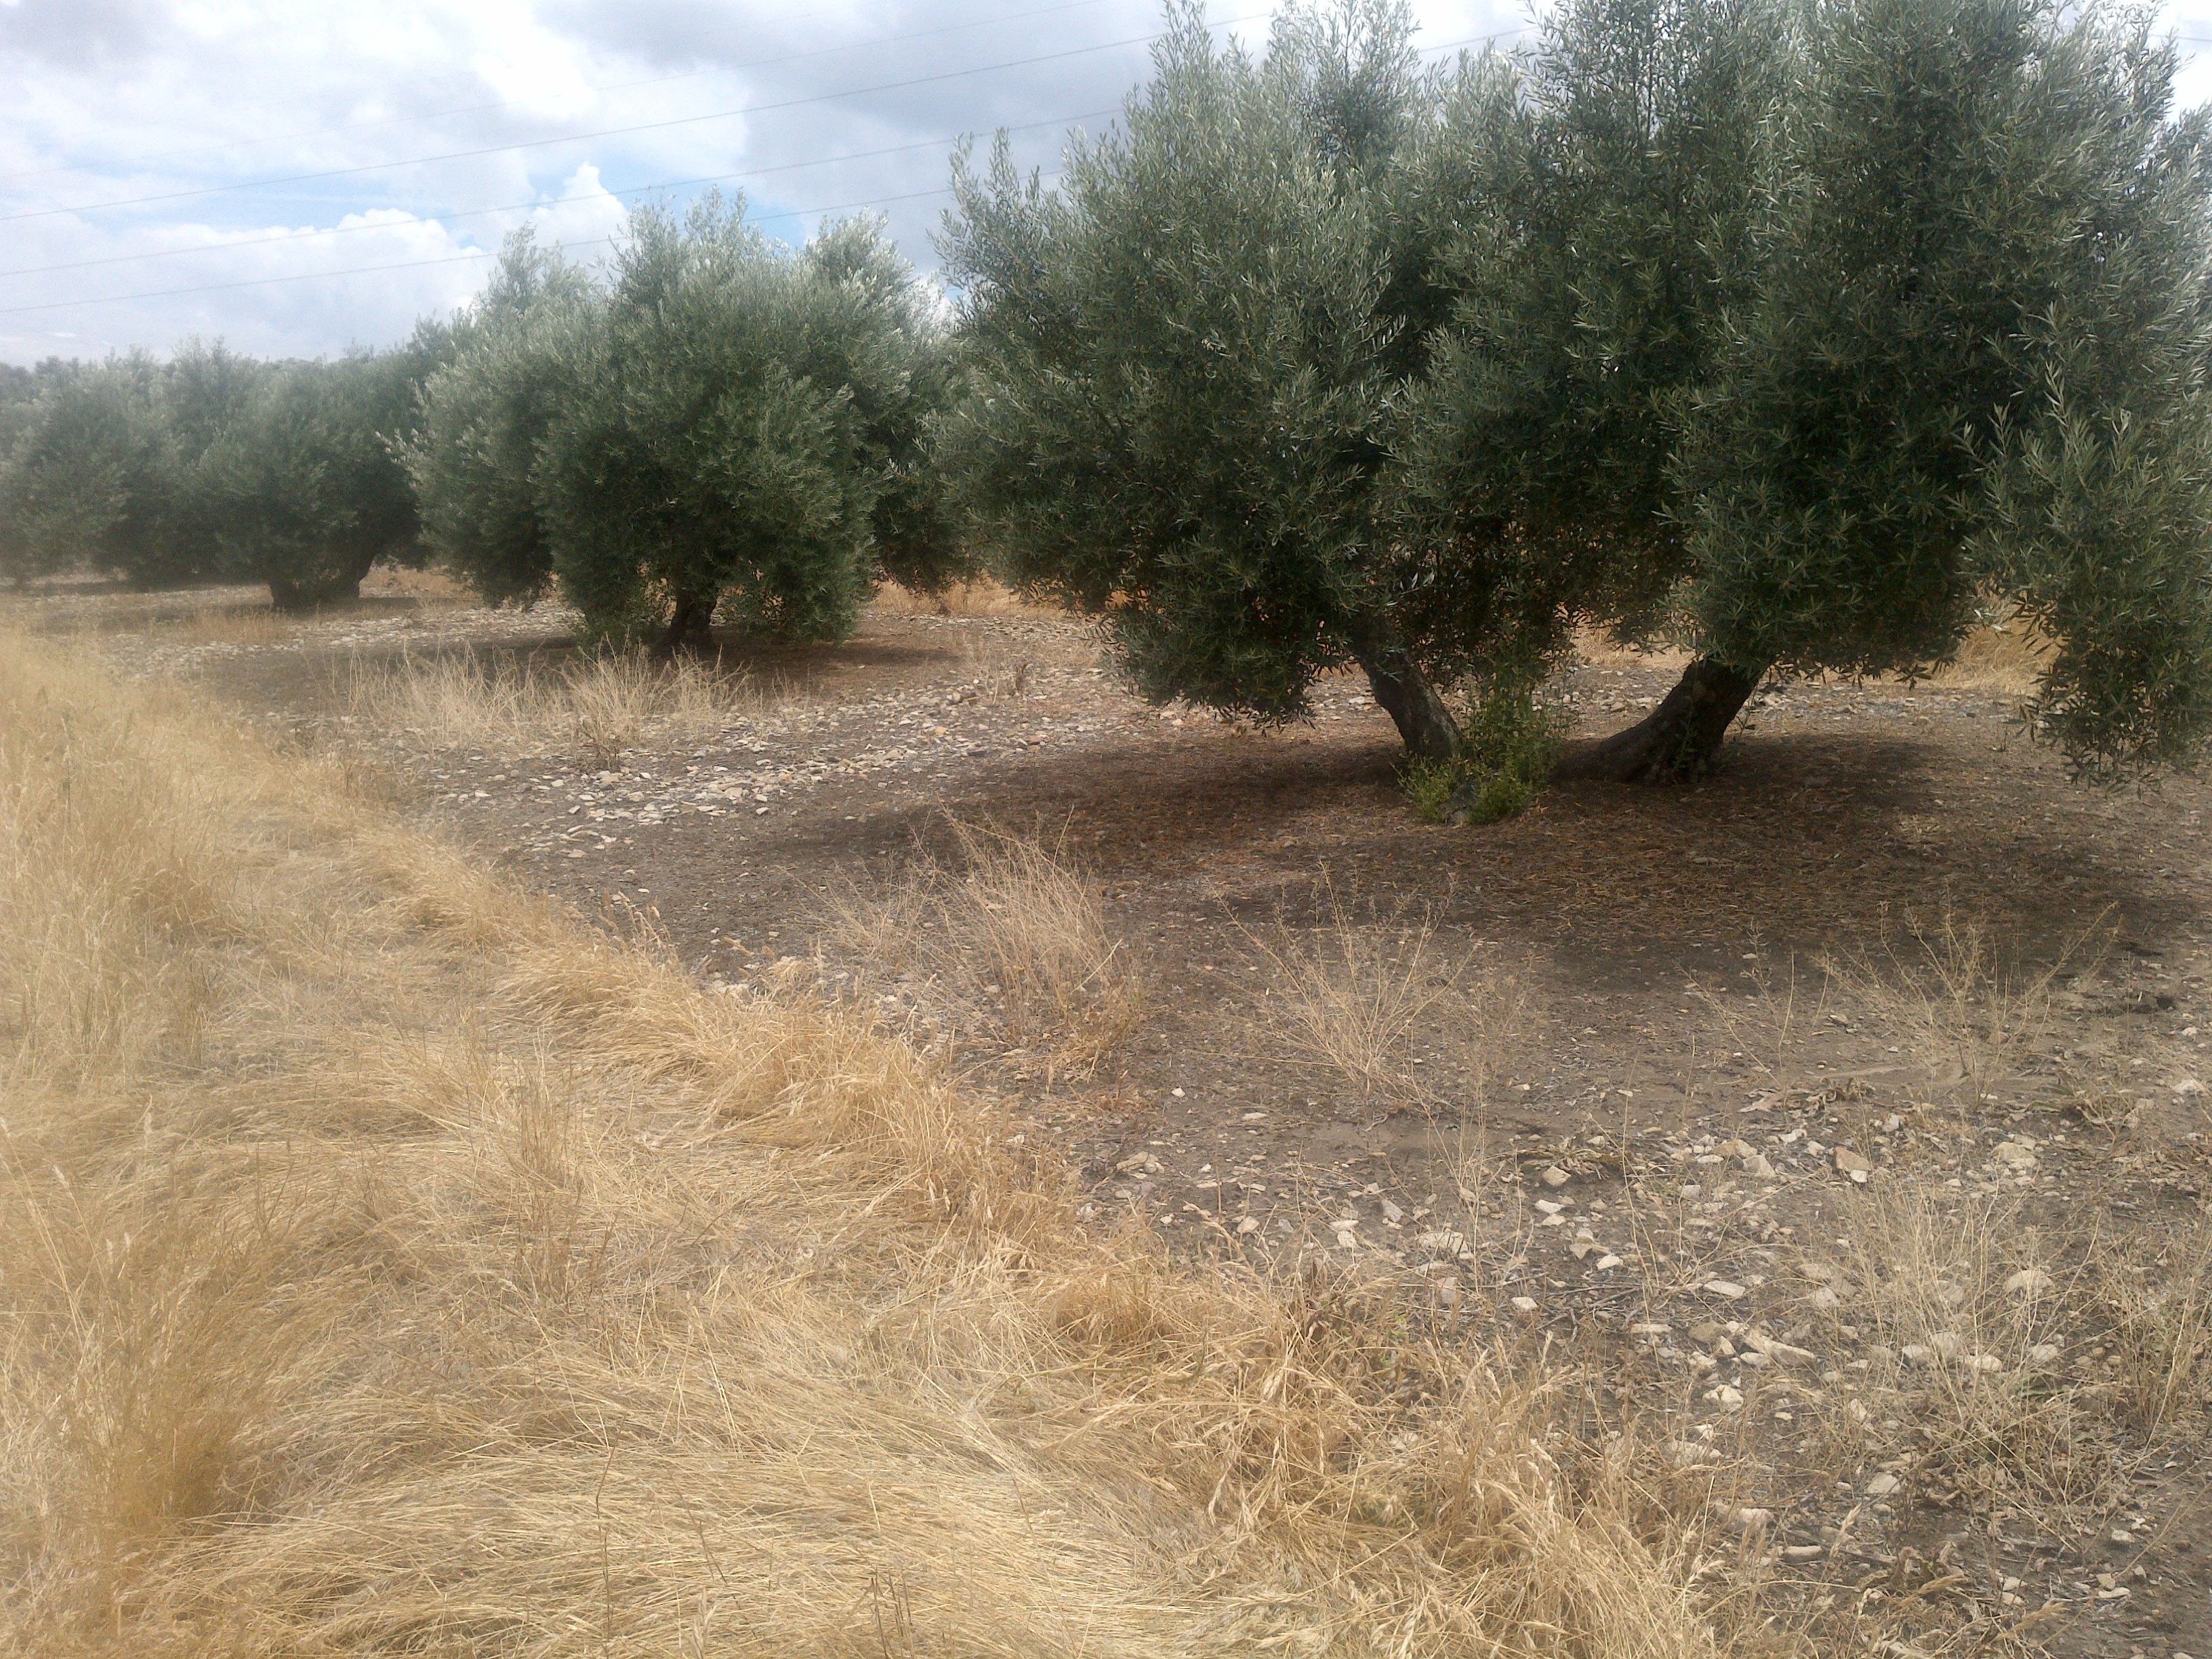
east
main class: Cropland
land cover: Olive groves
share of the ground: 50 - 75 %
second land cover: Spontaneously vegetated surfaces
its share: 10 - 25 %
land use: Agriculture (excluding fallow land and kitchen gardens)
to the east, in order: Olive groves; Spontaneously vegetated surfaces; Other bare soil; Grass margins; Paved roads, cycling and walking lanes; Grass margins; Ditches and canals; Grass margins; Olive groves; Electric lines; Olive groves
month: June
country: ES
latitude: 37.8172
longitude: -4.3092
